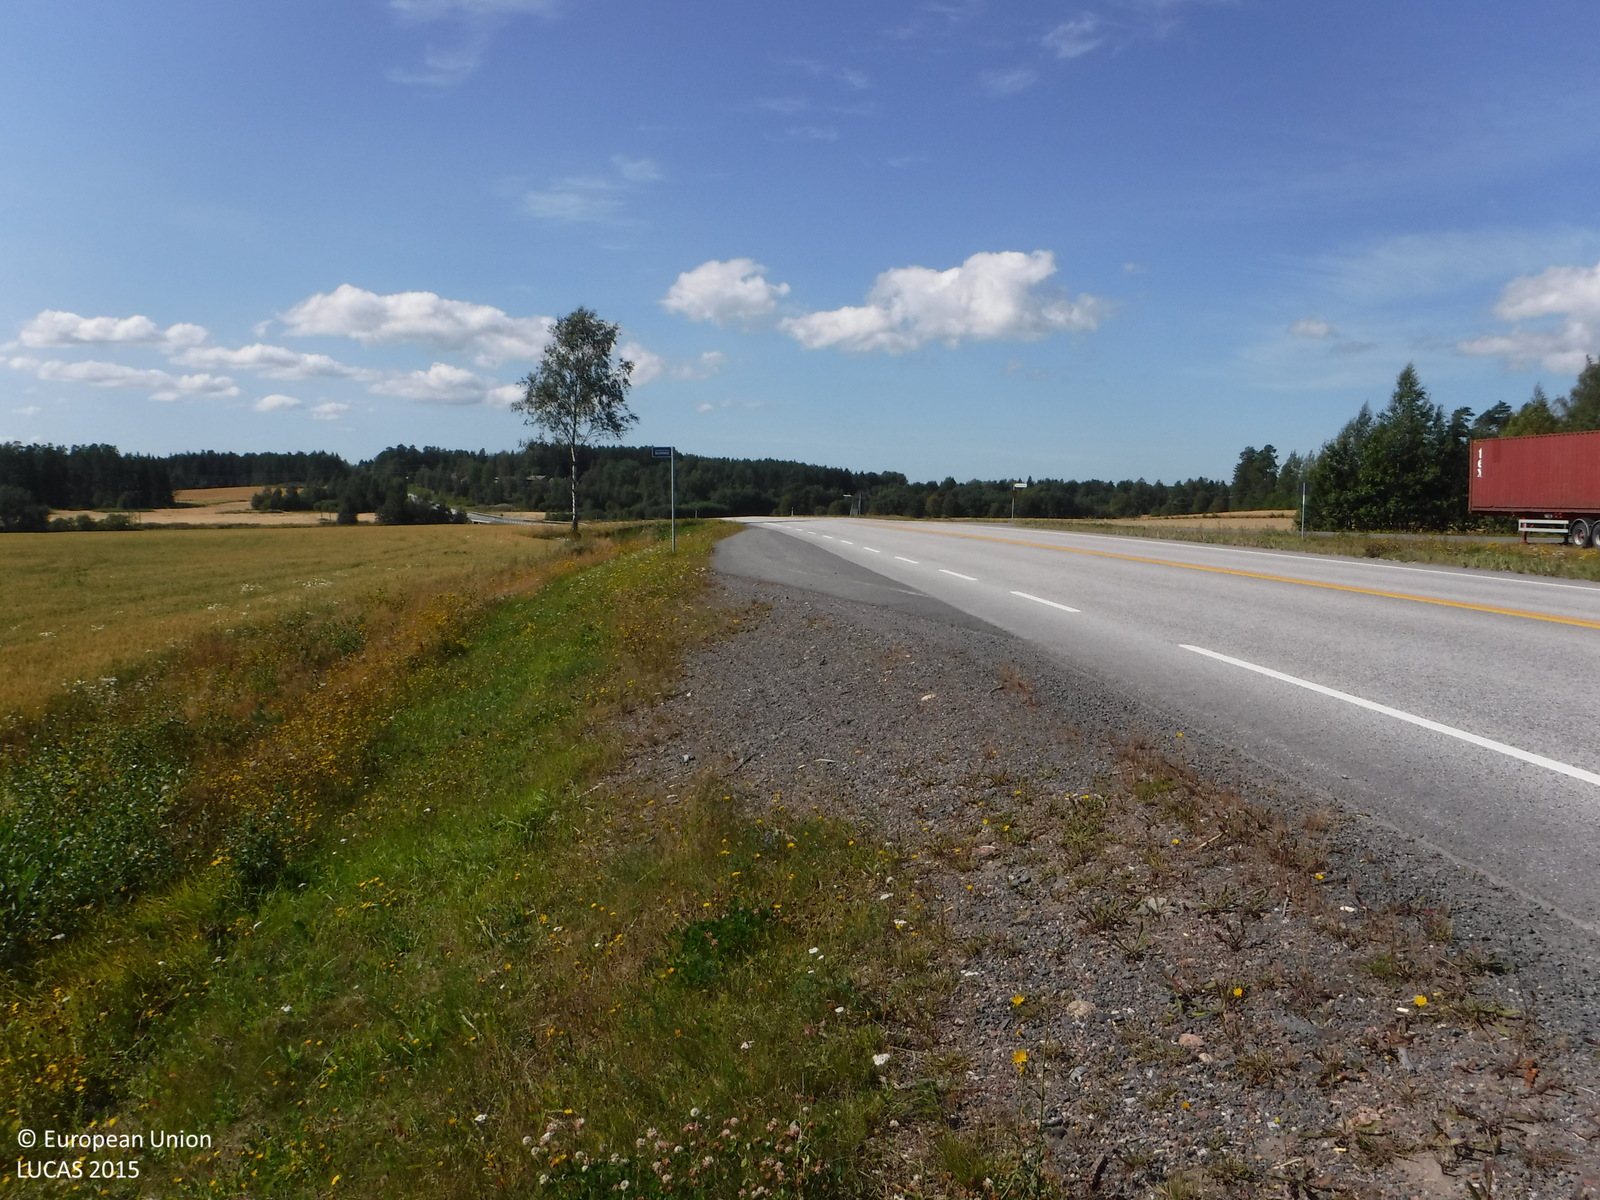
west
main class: Cropland
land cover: Common wheat
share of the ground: > 75 %
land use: Agriculture (excluding fallow land and kitchen gardens)
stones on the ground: < 10 %
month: August
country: FI
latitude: 61.1000
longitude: 21.8734
